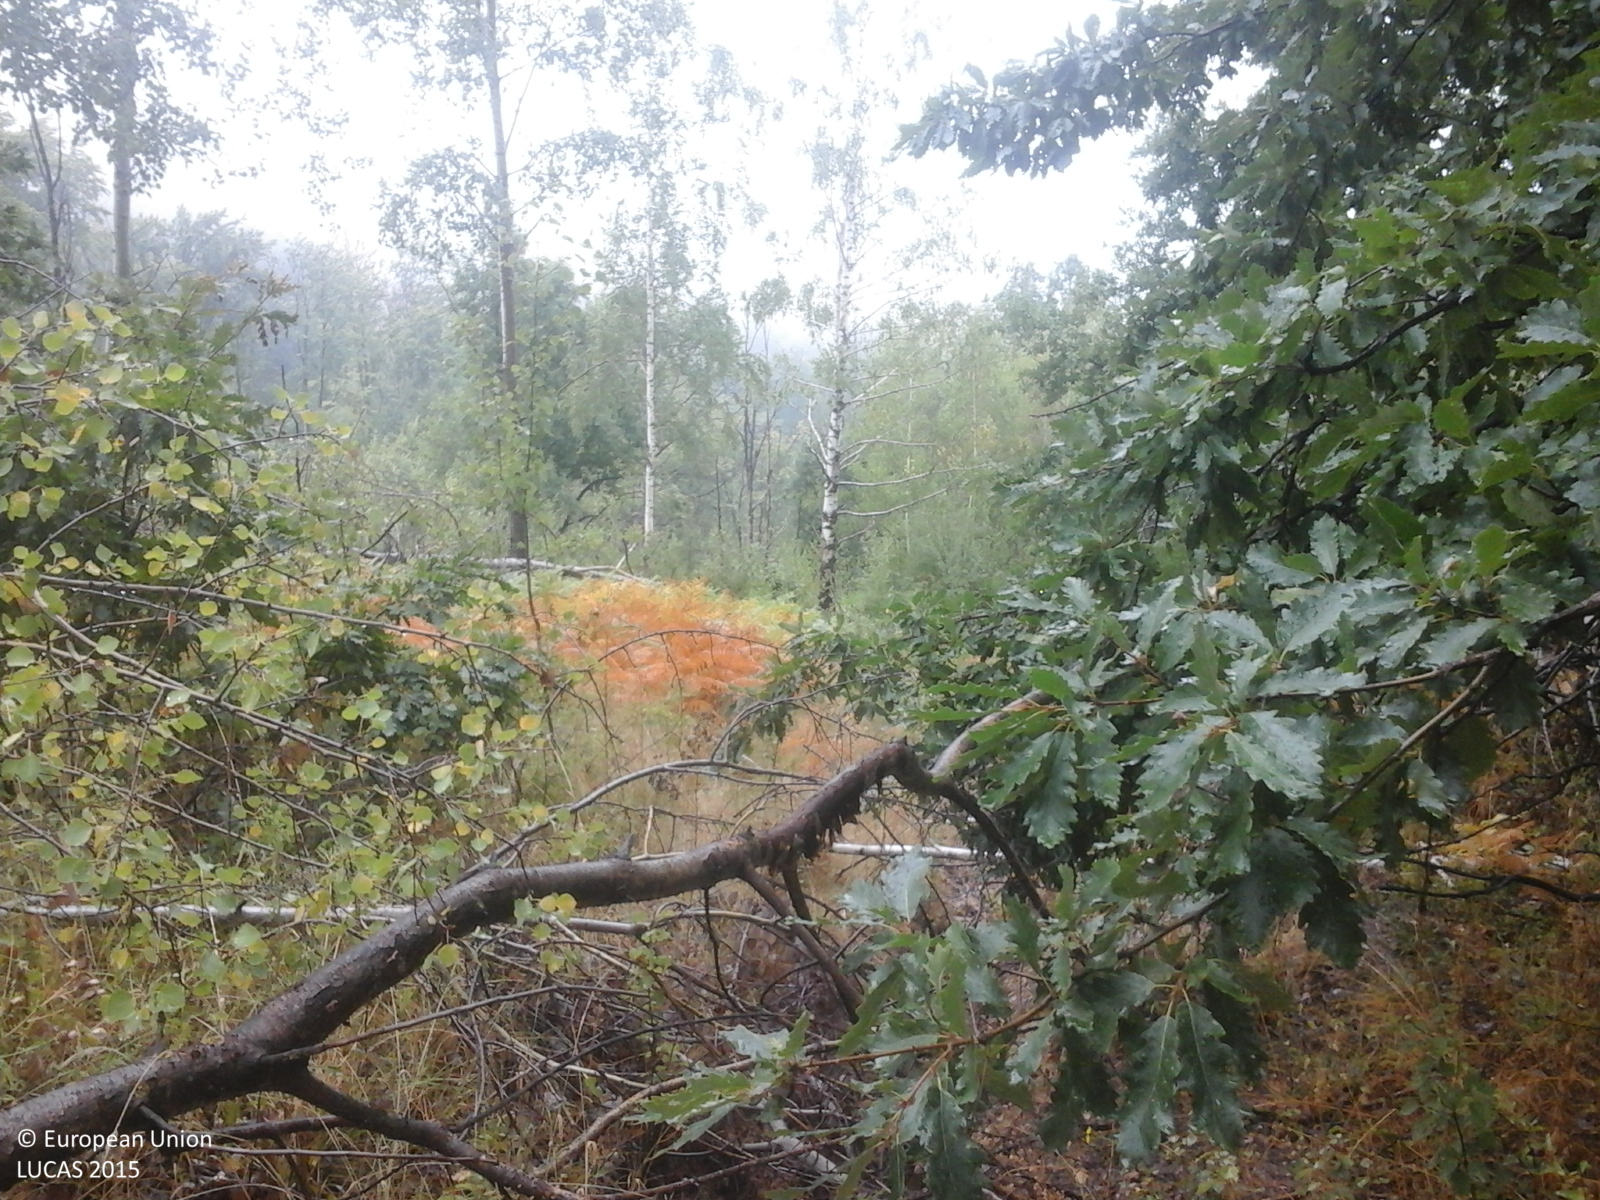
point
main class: Woodland
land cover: Broadleaved woodland
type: acidophilous oak and oak-birch forest
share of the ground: > 75 %
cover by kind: broadleaved forest trees 100 %
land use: Forestry
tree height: > 5 m
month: August
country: RO
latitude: 44.9614
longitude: 22.1694
